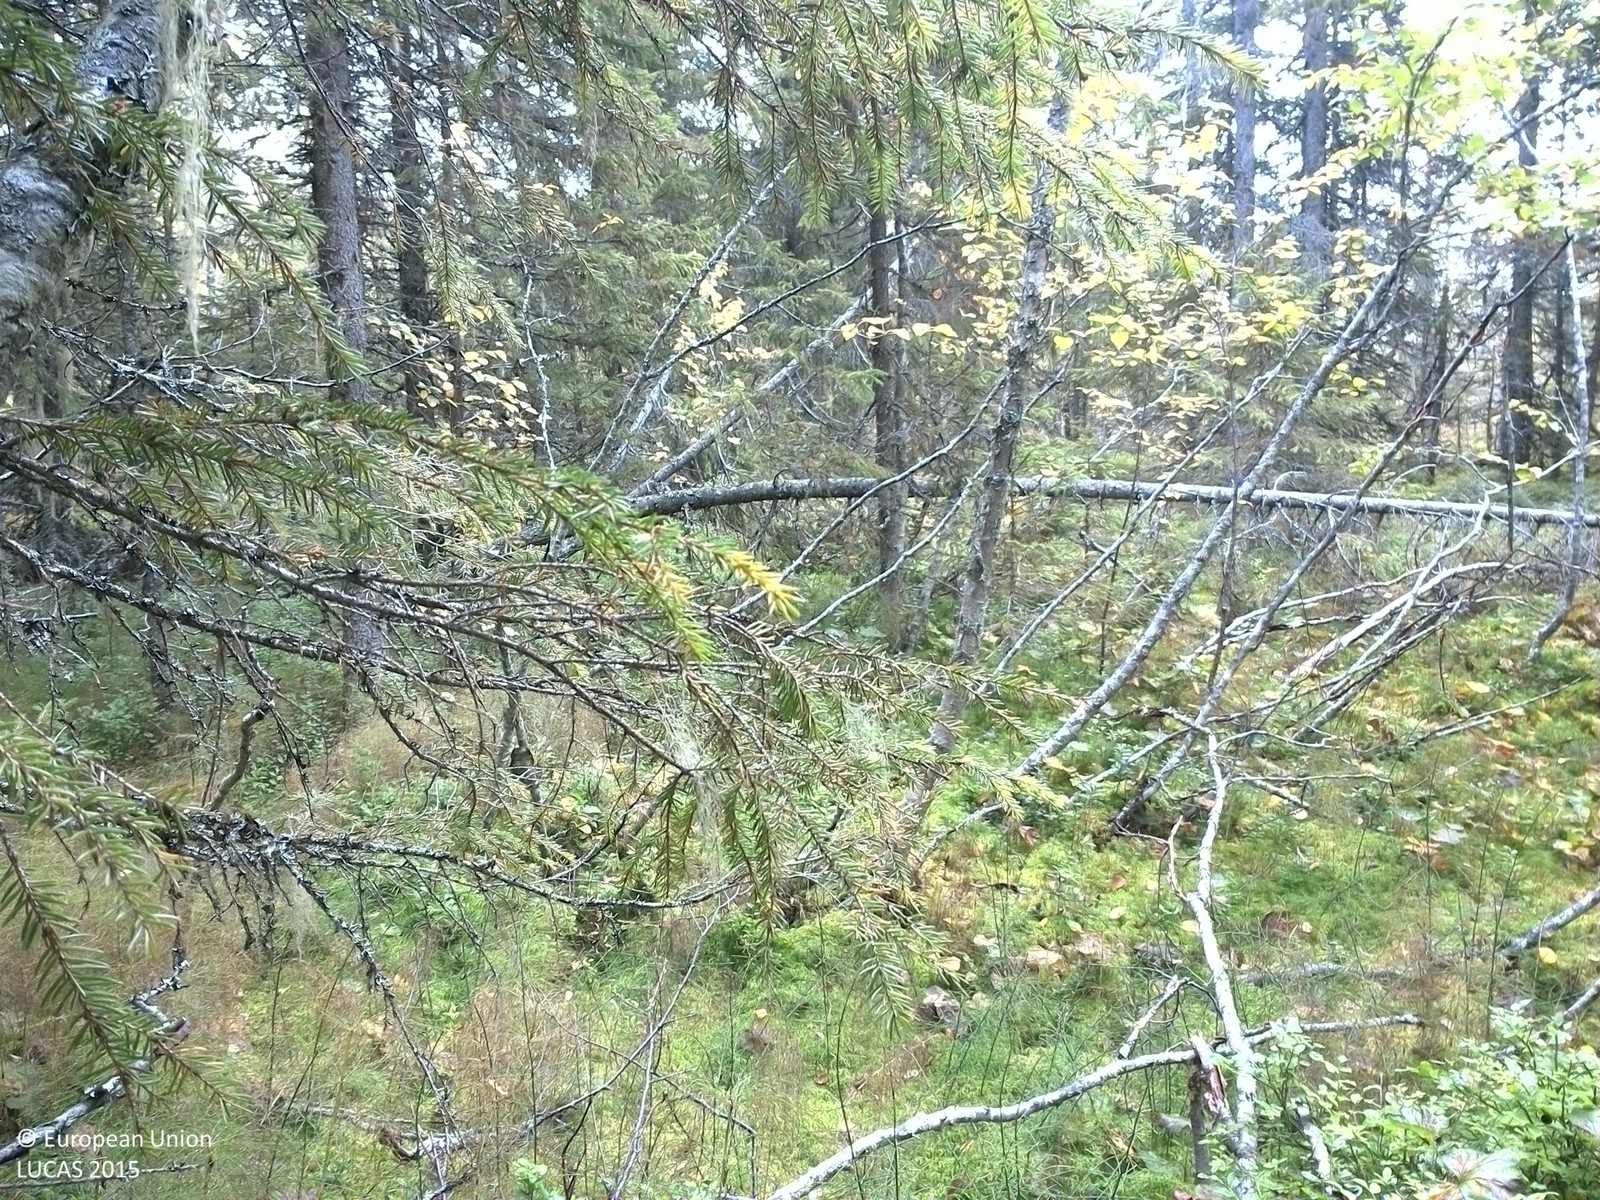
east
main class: Woodland
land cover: Spruce dominated mixed woodland
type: mire and swamp forests
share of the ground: 50 - 75 %
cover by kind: coniferous forest trees 50 %, broadleaved forest trees 20 %, lichens and mosses 15 %, shrubs 10 %, herbaceous plants 5 %
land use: Forestry
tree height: > 5 m
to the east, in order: Spruce dominated mixed woodland; Pine dominated coniferous woodland; Other mixed woodland; Pine dominated coniferous woodland
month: September
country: SE
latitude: 63.7291
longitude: 16.3109
